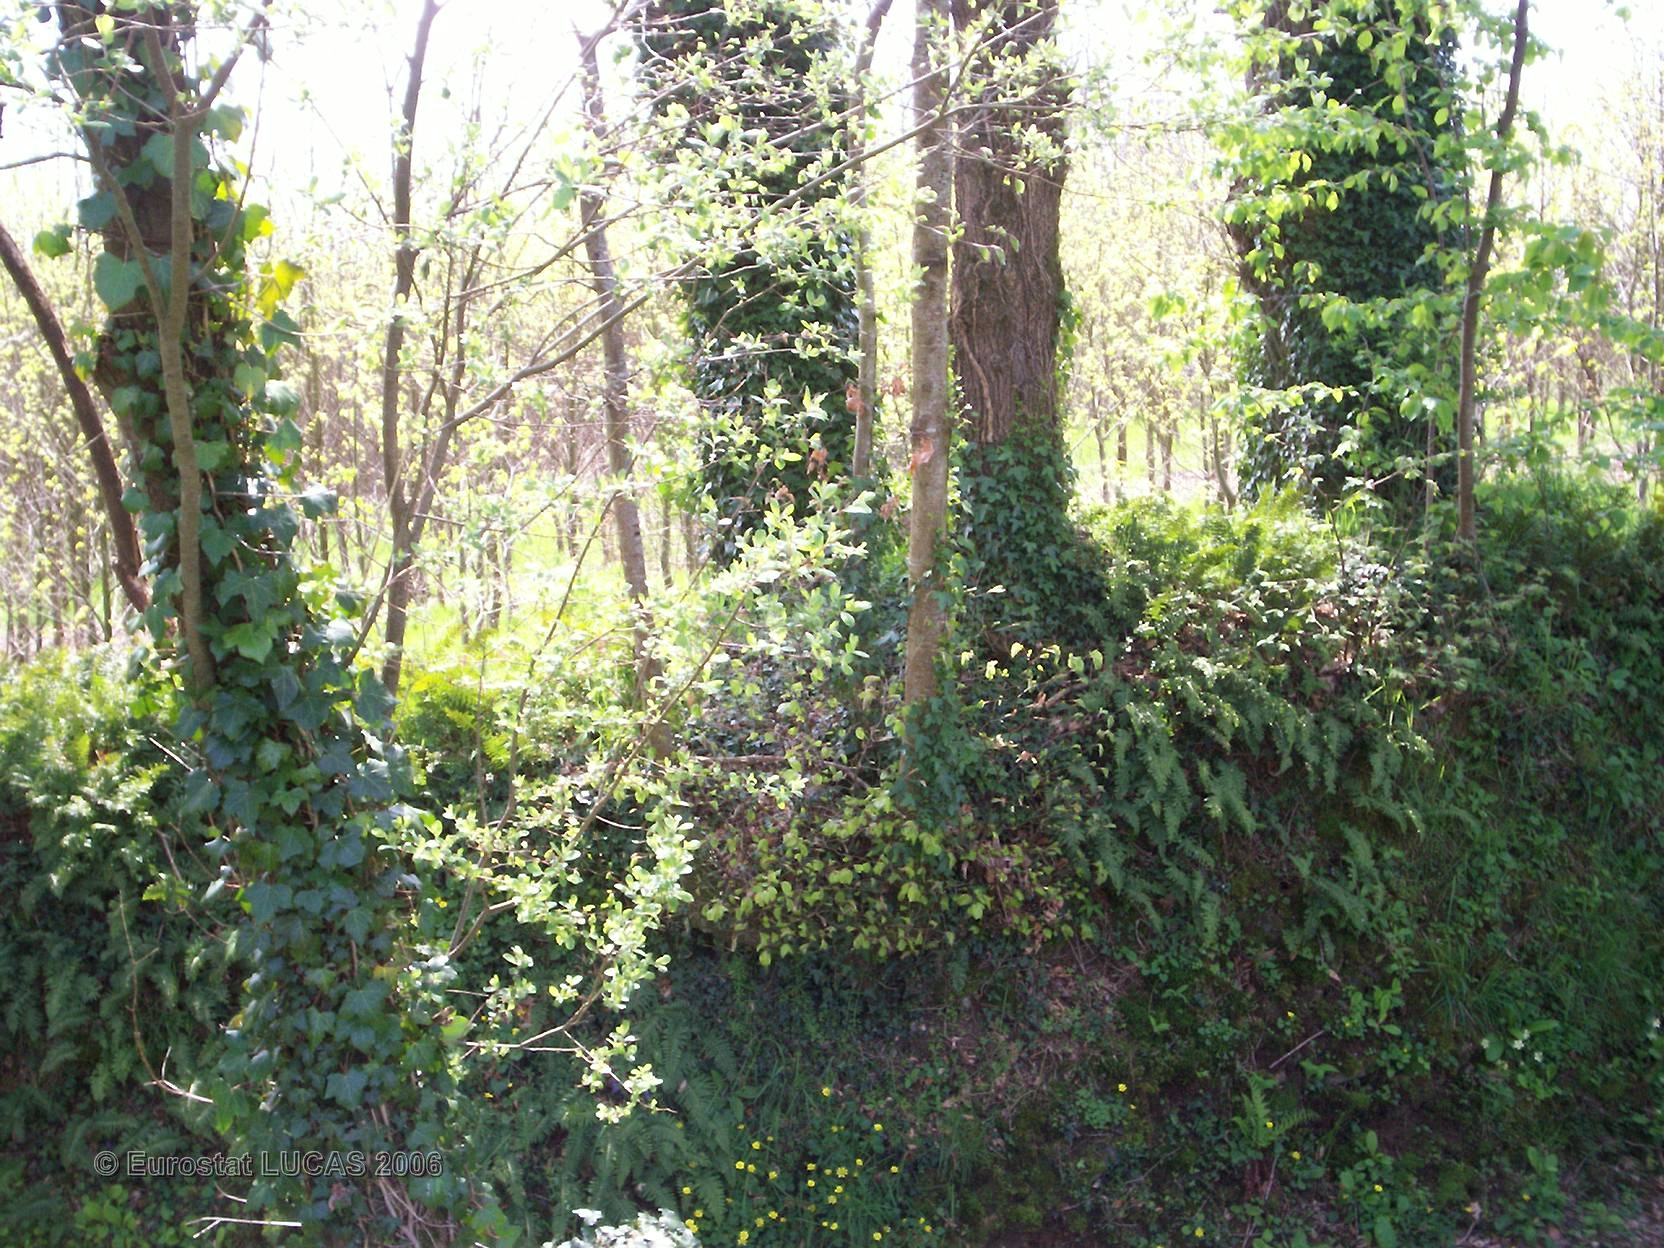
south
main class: Grassland
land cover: Grassland without tree/shrub cover
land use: Agriculture (excluding fallow land and kitchen gardens)
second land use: Sport
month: May
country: FR
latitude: 48.2768
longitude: -2.4705
